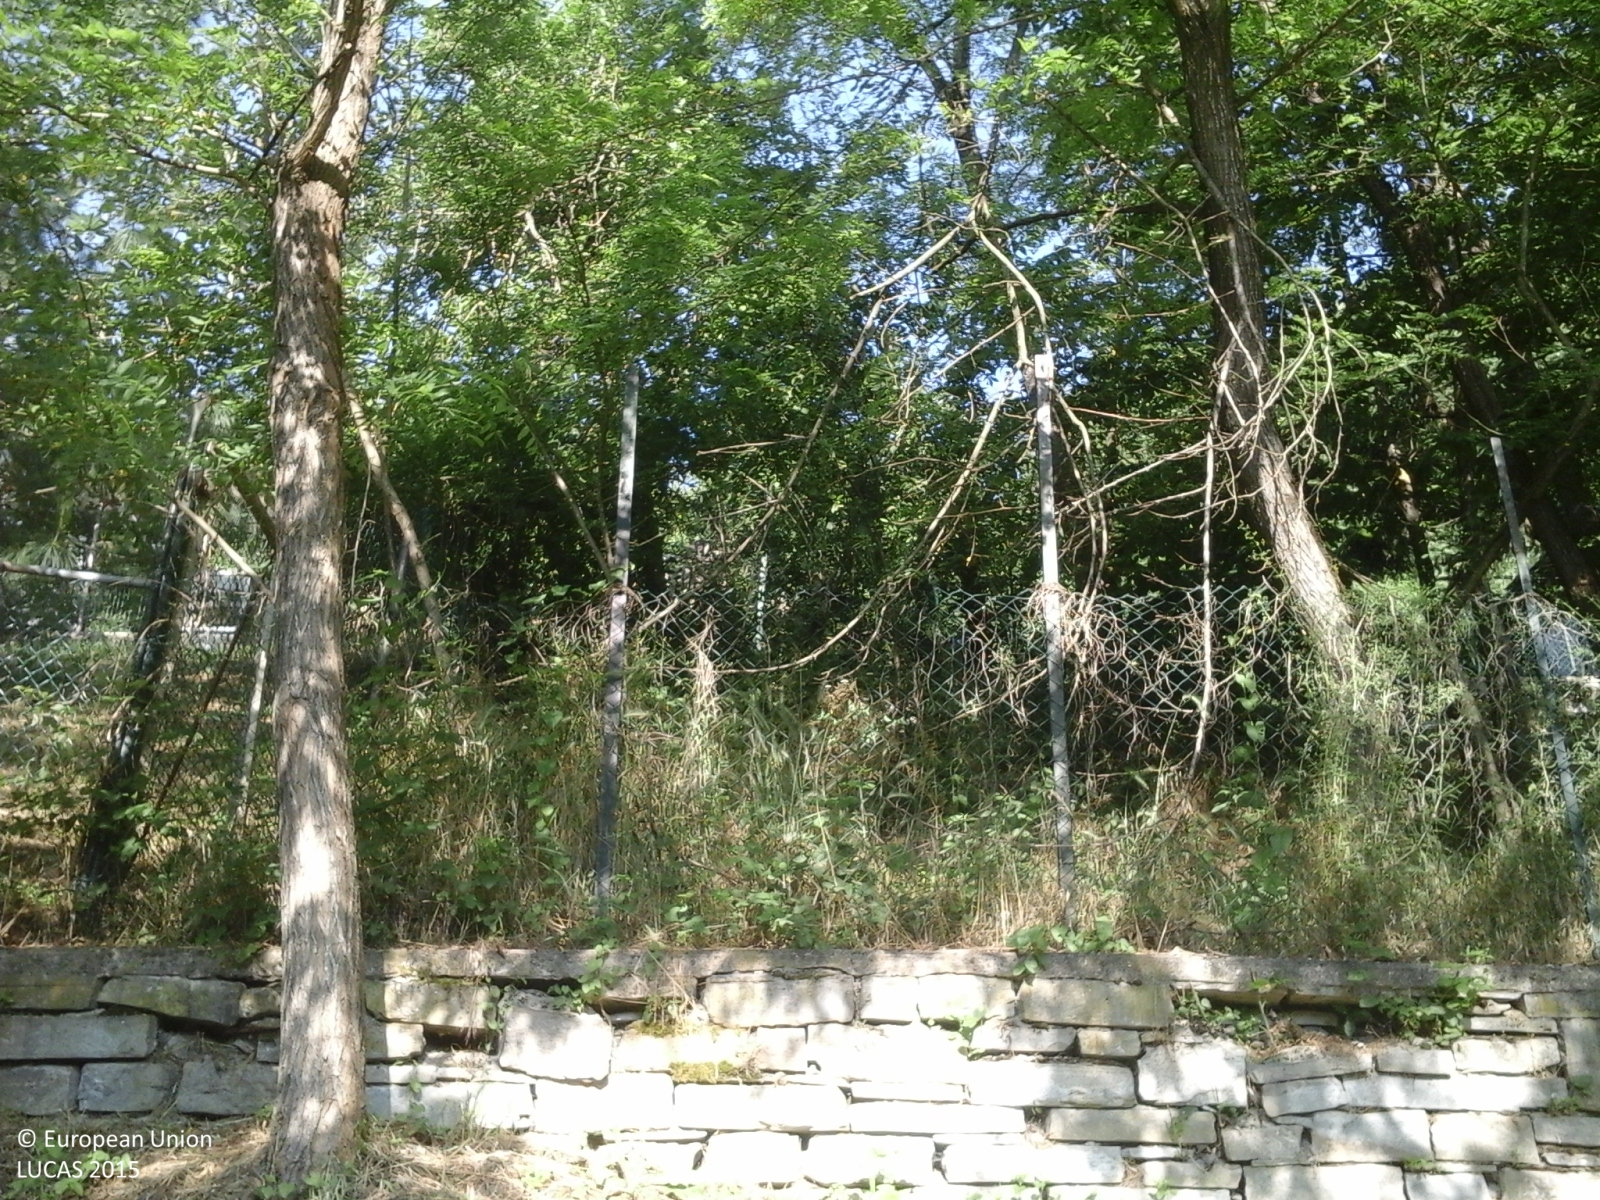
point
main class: Woodland
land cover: Broadleaved woodland
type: thermophilous deciduous forest
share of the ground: > 75 %
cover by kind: broadleaved forest trees 100 %
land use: Forestry
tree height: > 5 m
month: June
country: IT
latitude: 44.3848
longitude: 10.6136
